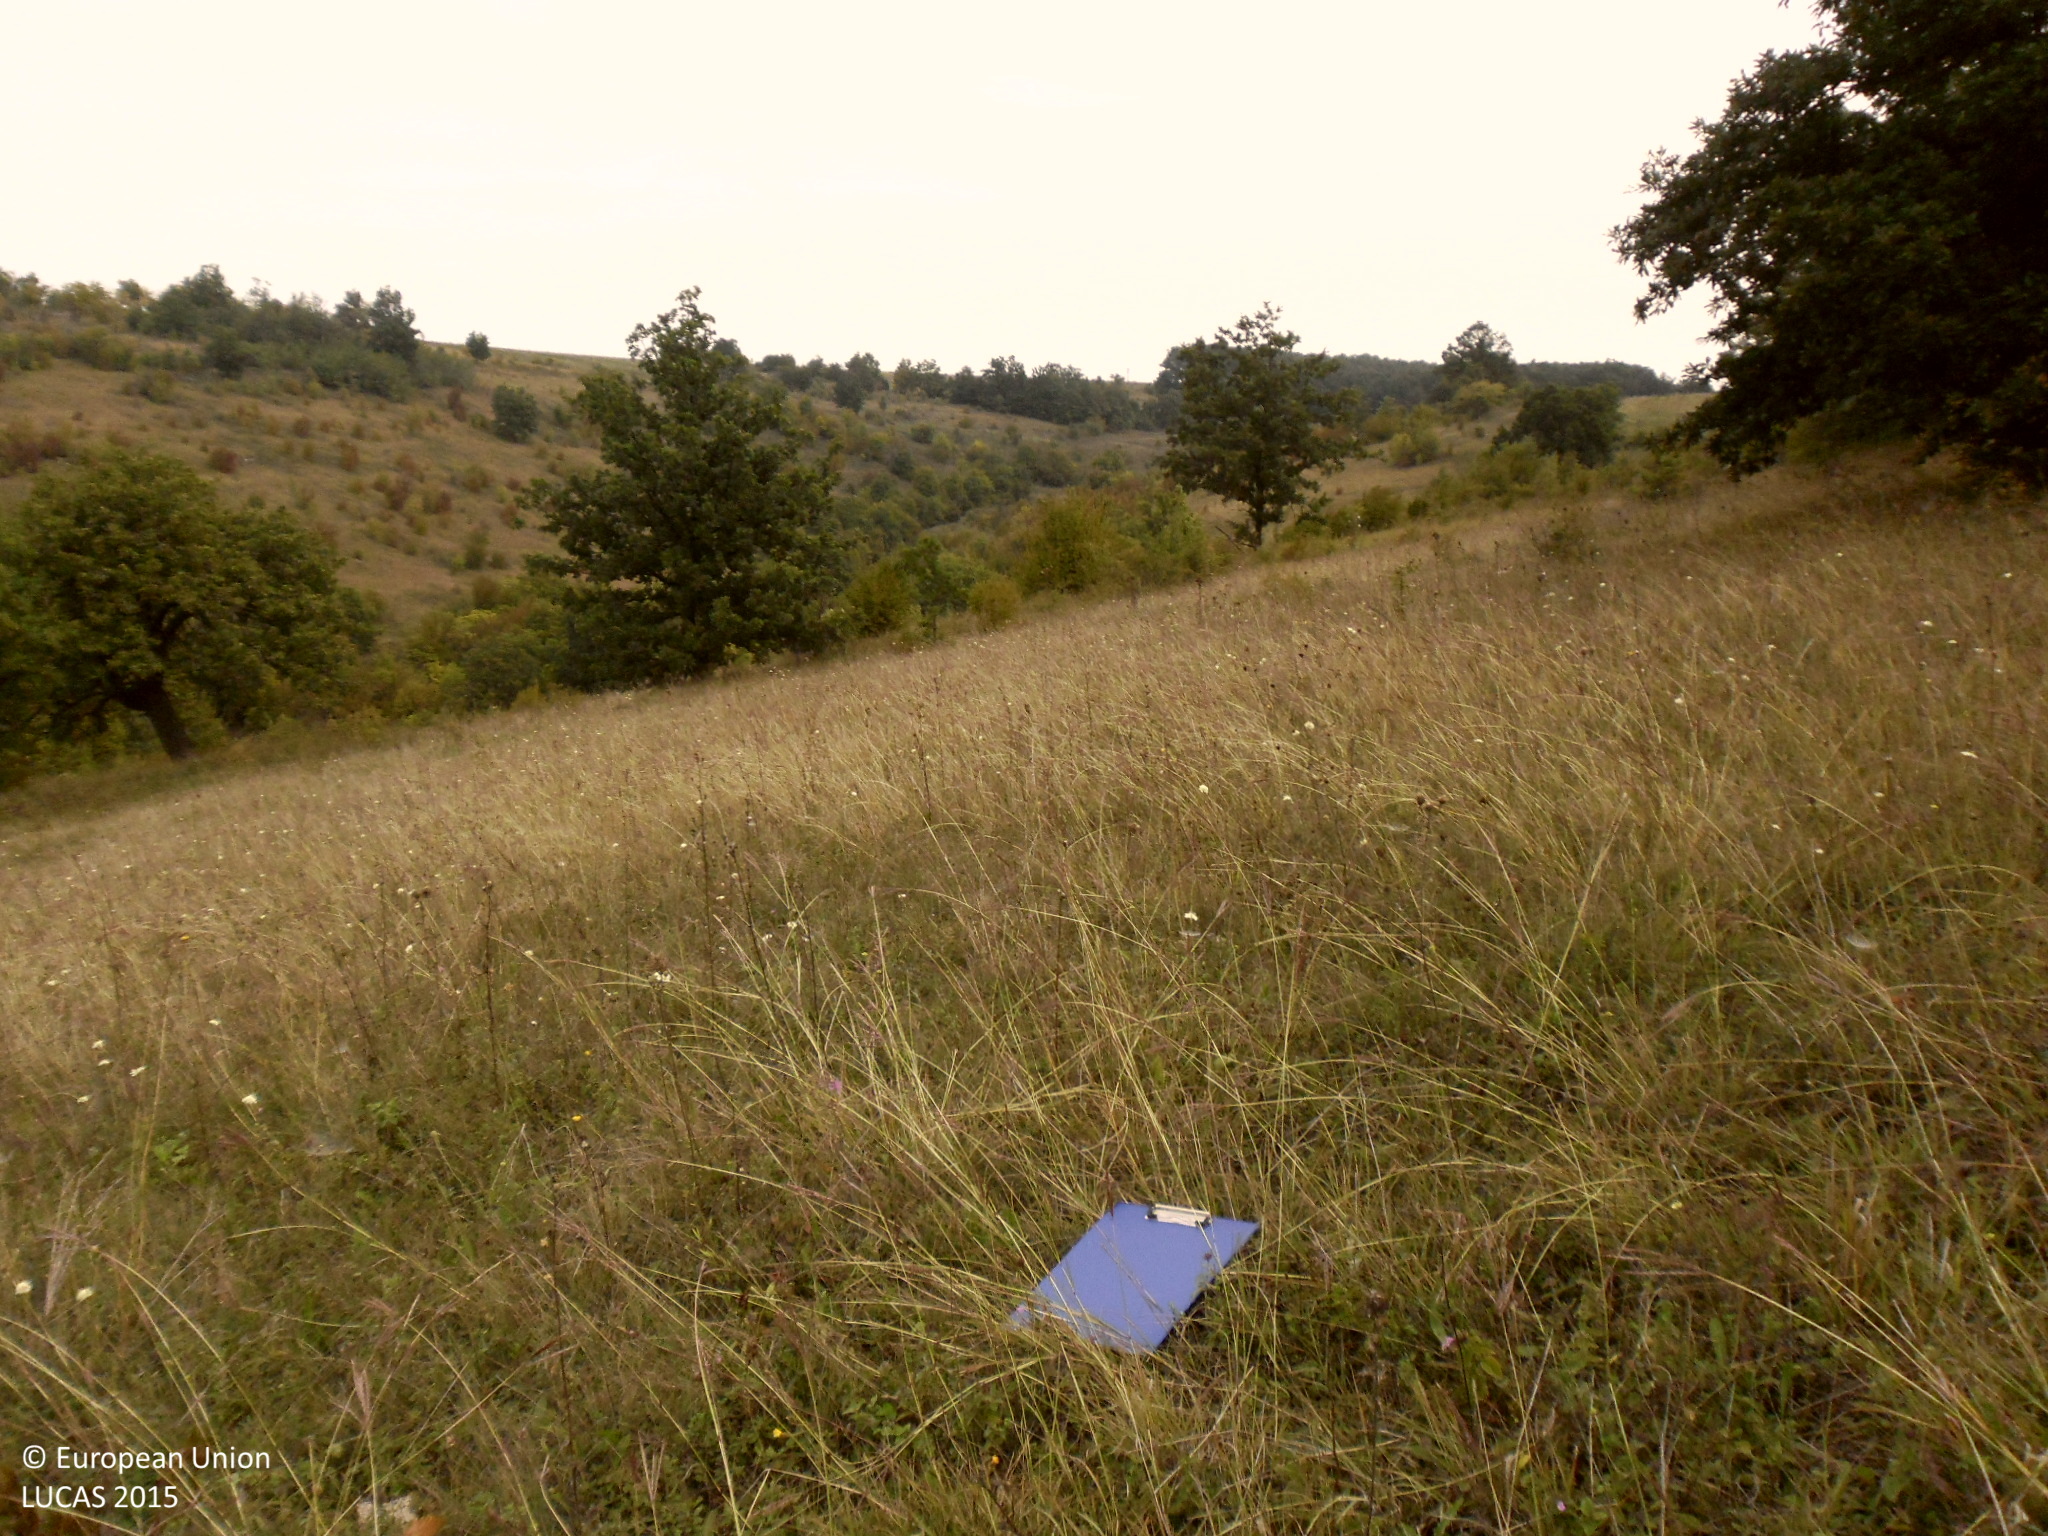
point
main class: Grassland
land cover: Grassland with sparse tree/shrub cover
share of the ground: > 75 %
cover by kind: herbaceous plants 90 %, broadleaved forest trees 5 %, shrubs 5 %
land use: Semi-natural and natural areas not in use
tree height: > 5 m
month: October
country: BG
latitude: 43.9963
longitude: 22.6184
